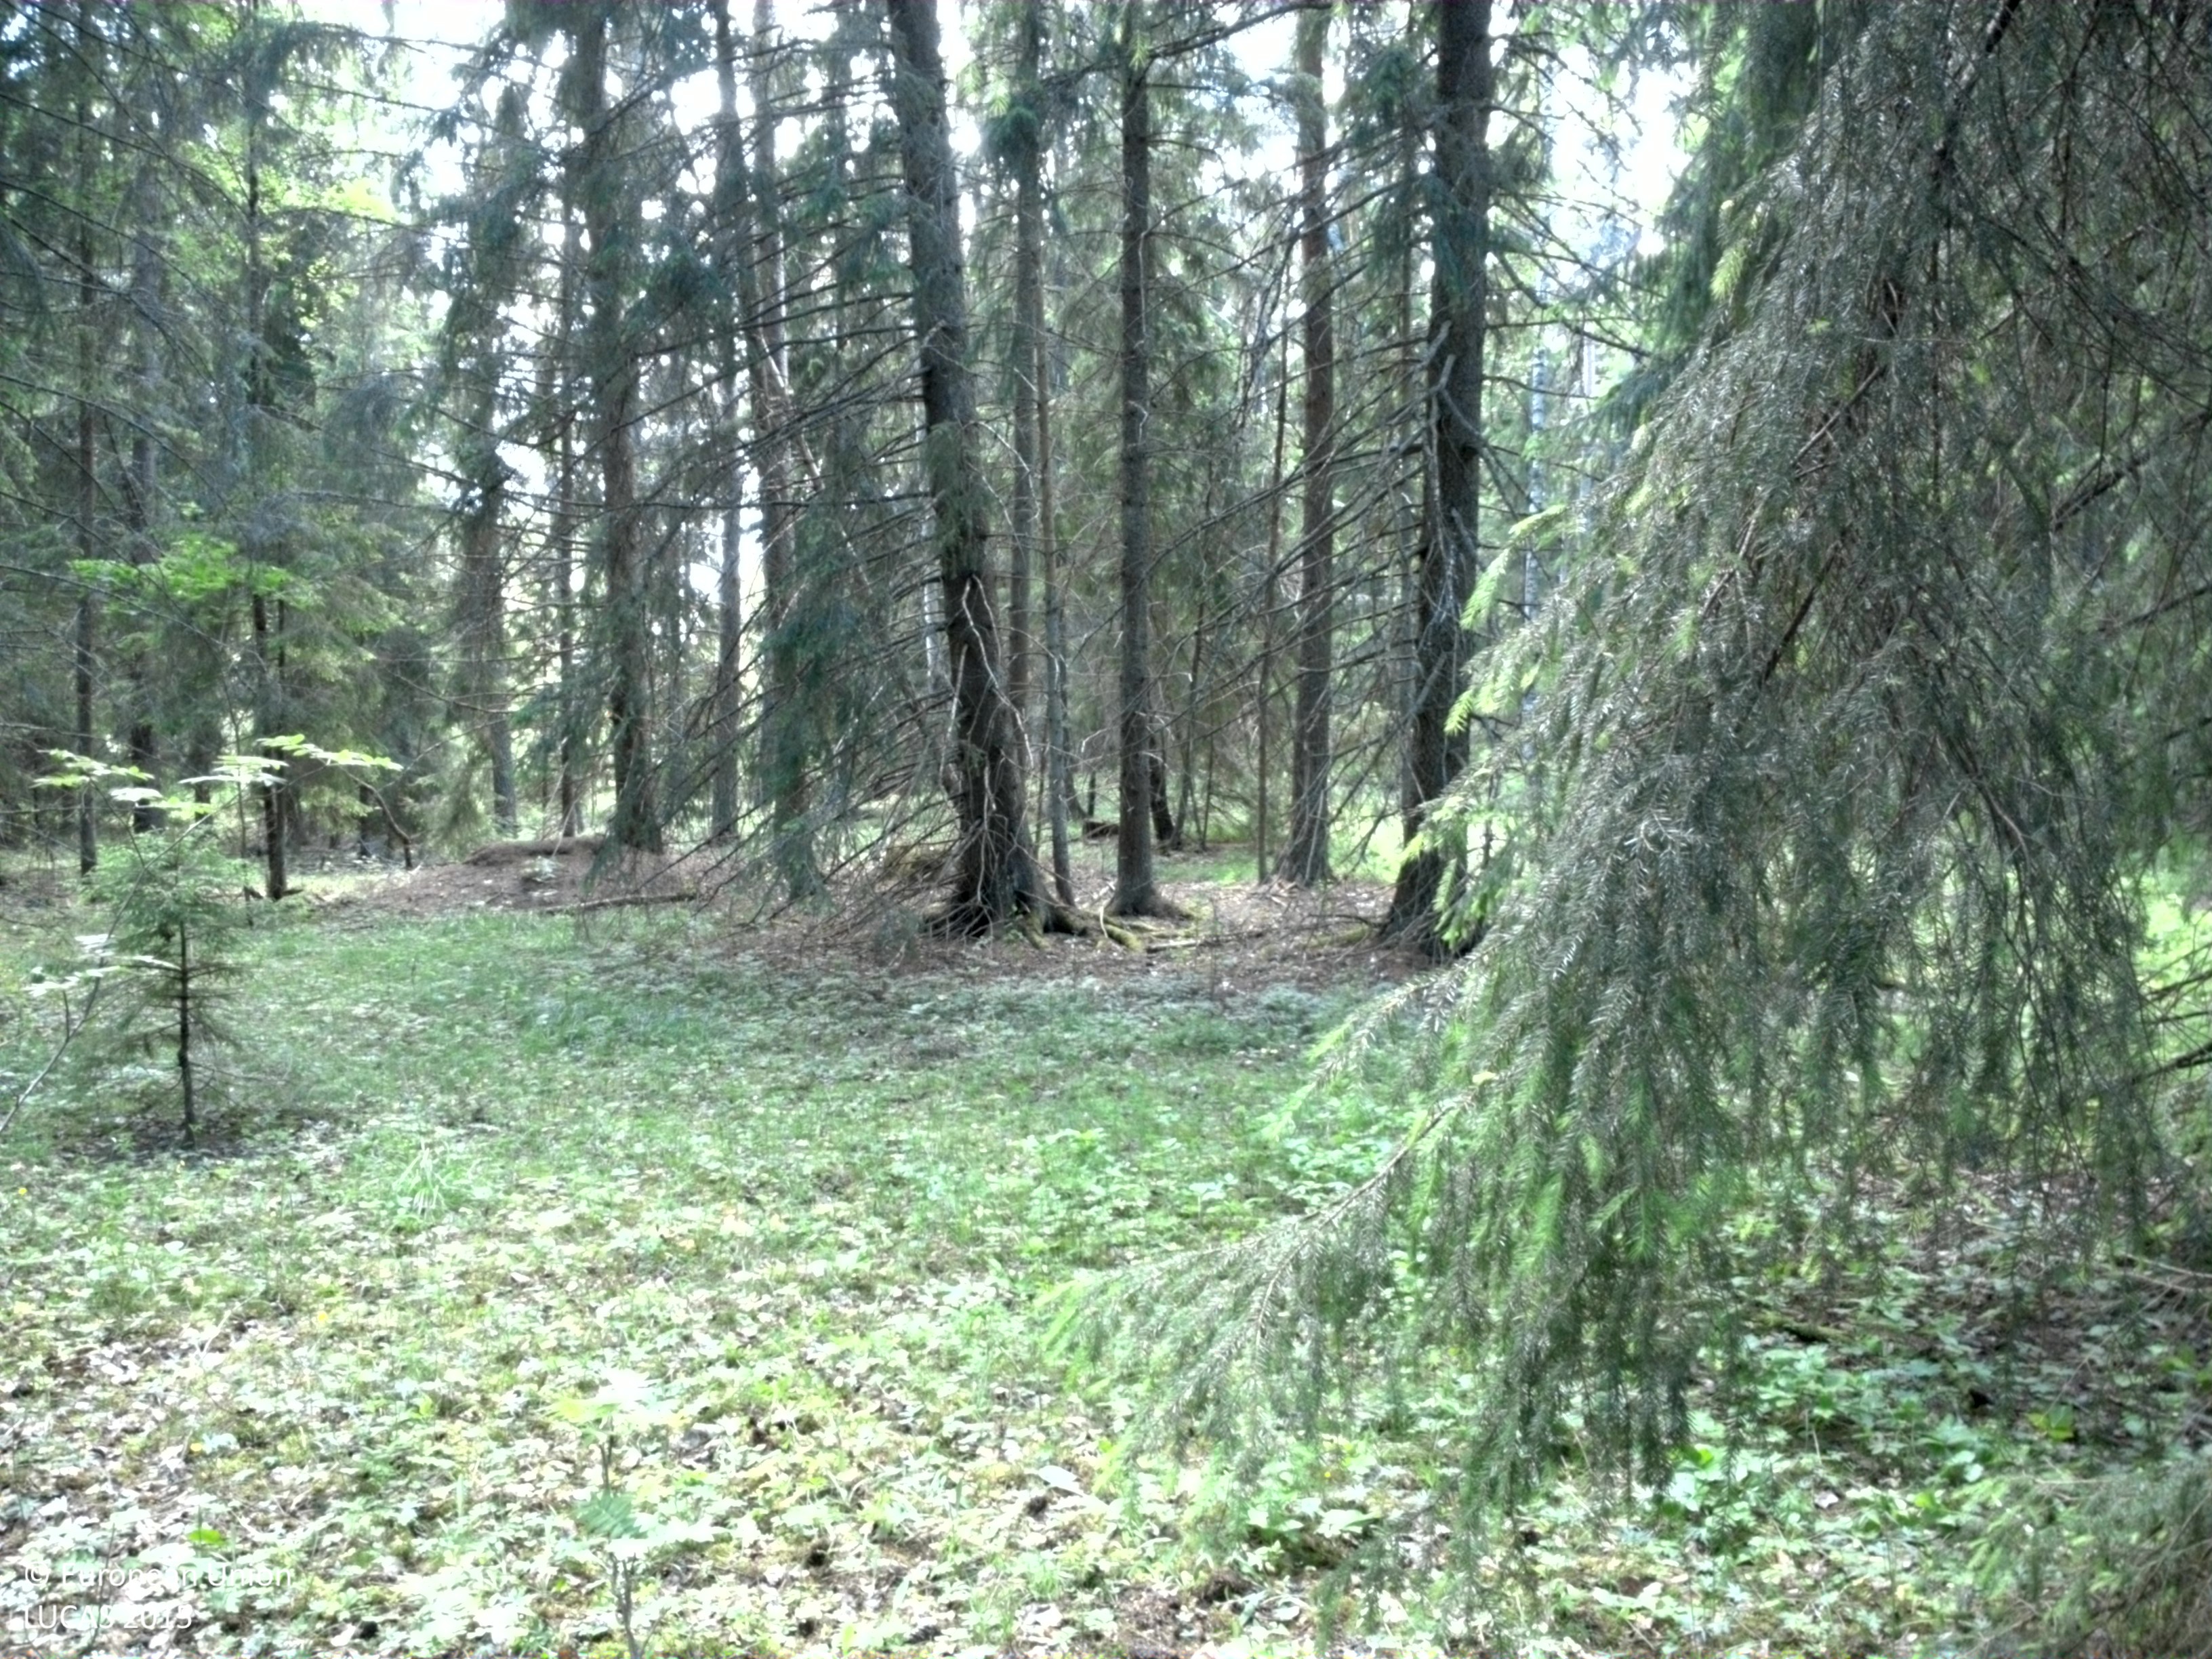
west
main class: Woodland
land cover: Spruce dominated coniferous woodland
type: boreal forest
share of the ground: > 75 %
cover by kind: coniferous forest trees 80 %, broadleaved forest trees 10 %, herbaceous plants 10 %
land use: Forestry
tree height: > 5 m
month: June
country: SE
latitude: 60.1802
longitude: 17.1485
